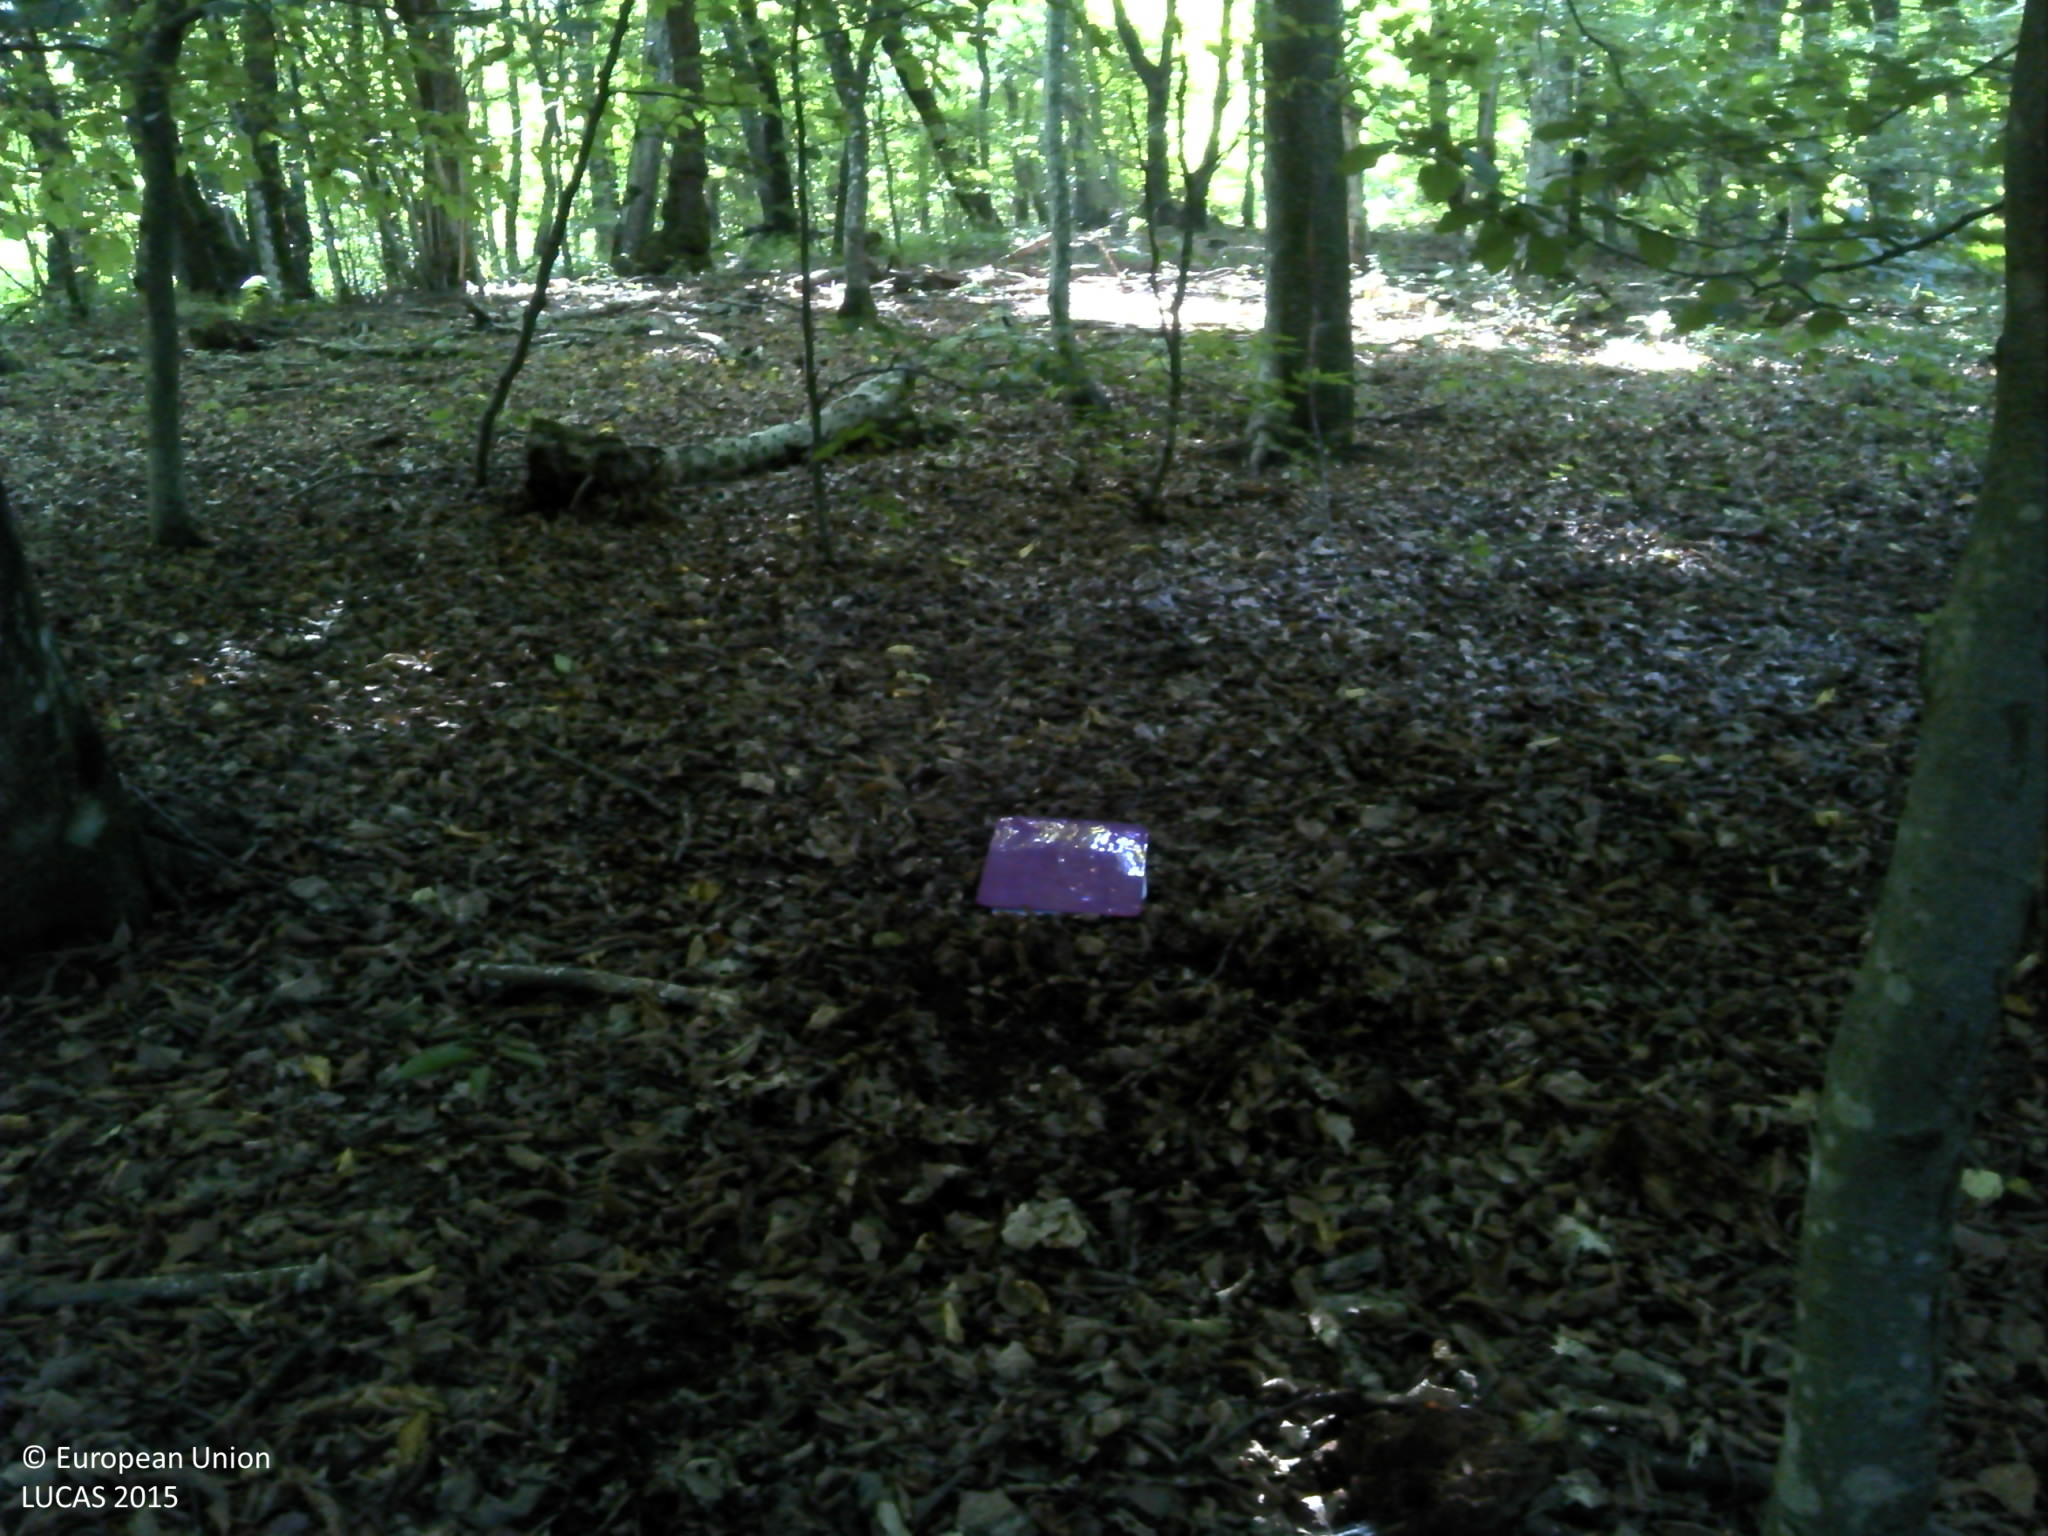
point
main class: Woodland
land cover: Broadleaved woodland
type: beech forest
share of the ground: > 75 %
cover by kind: broadleaved forest trees 100 %
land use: Forestry
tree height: > 5 m
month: August
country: HR
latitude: 45.3144
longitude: 15.6978
